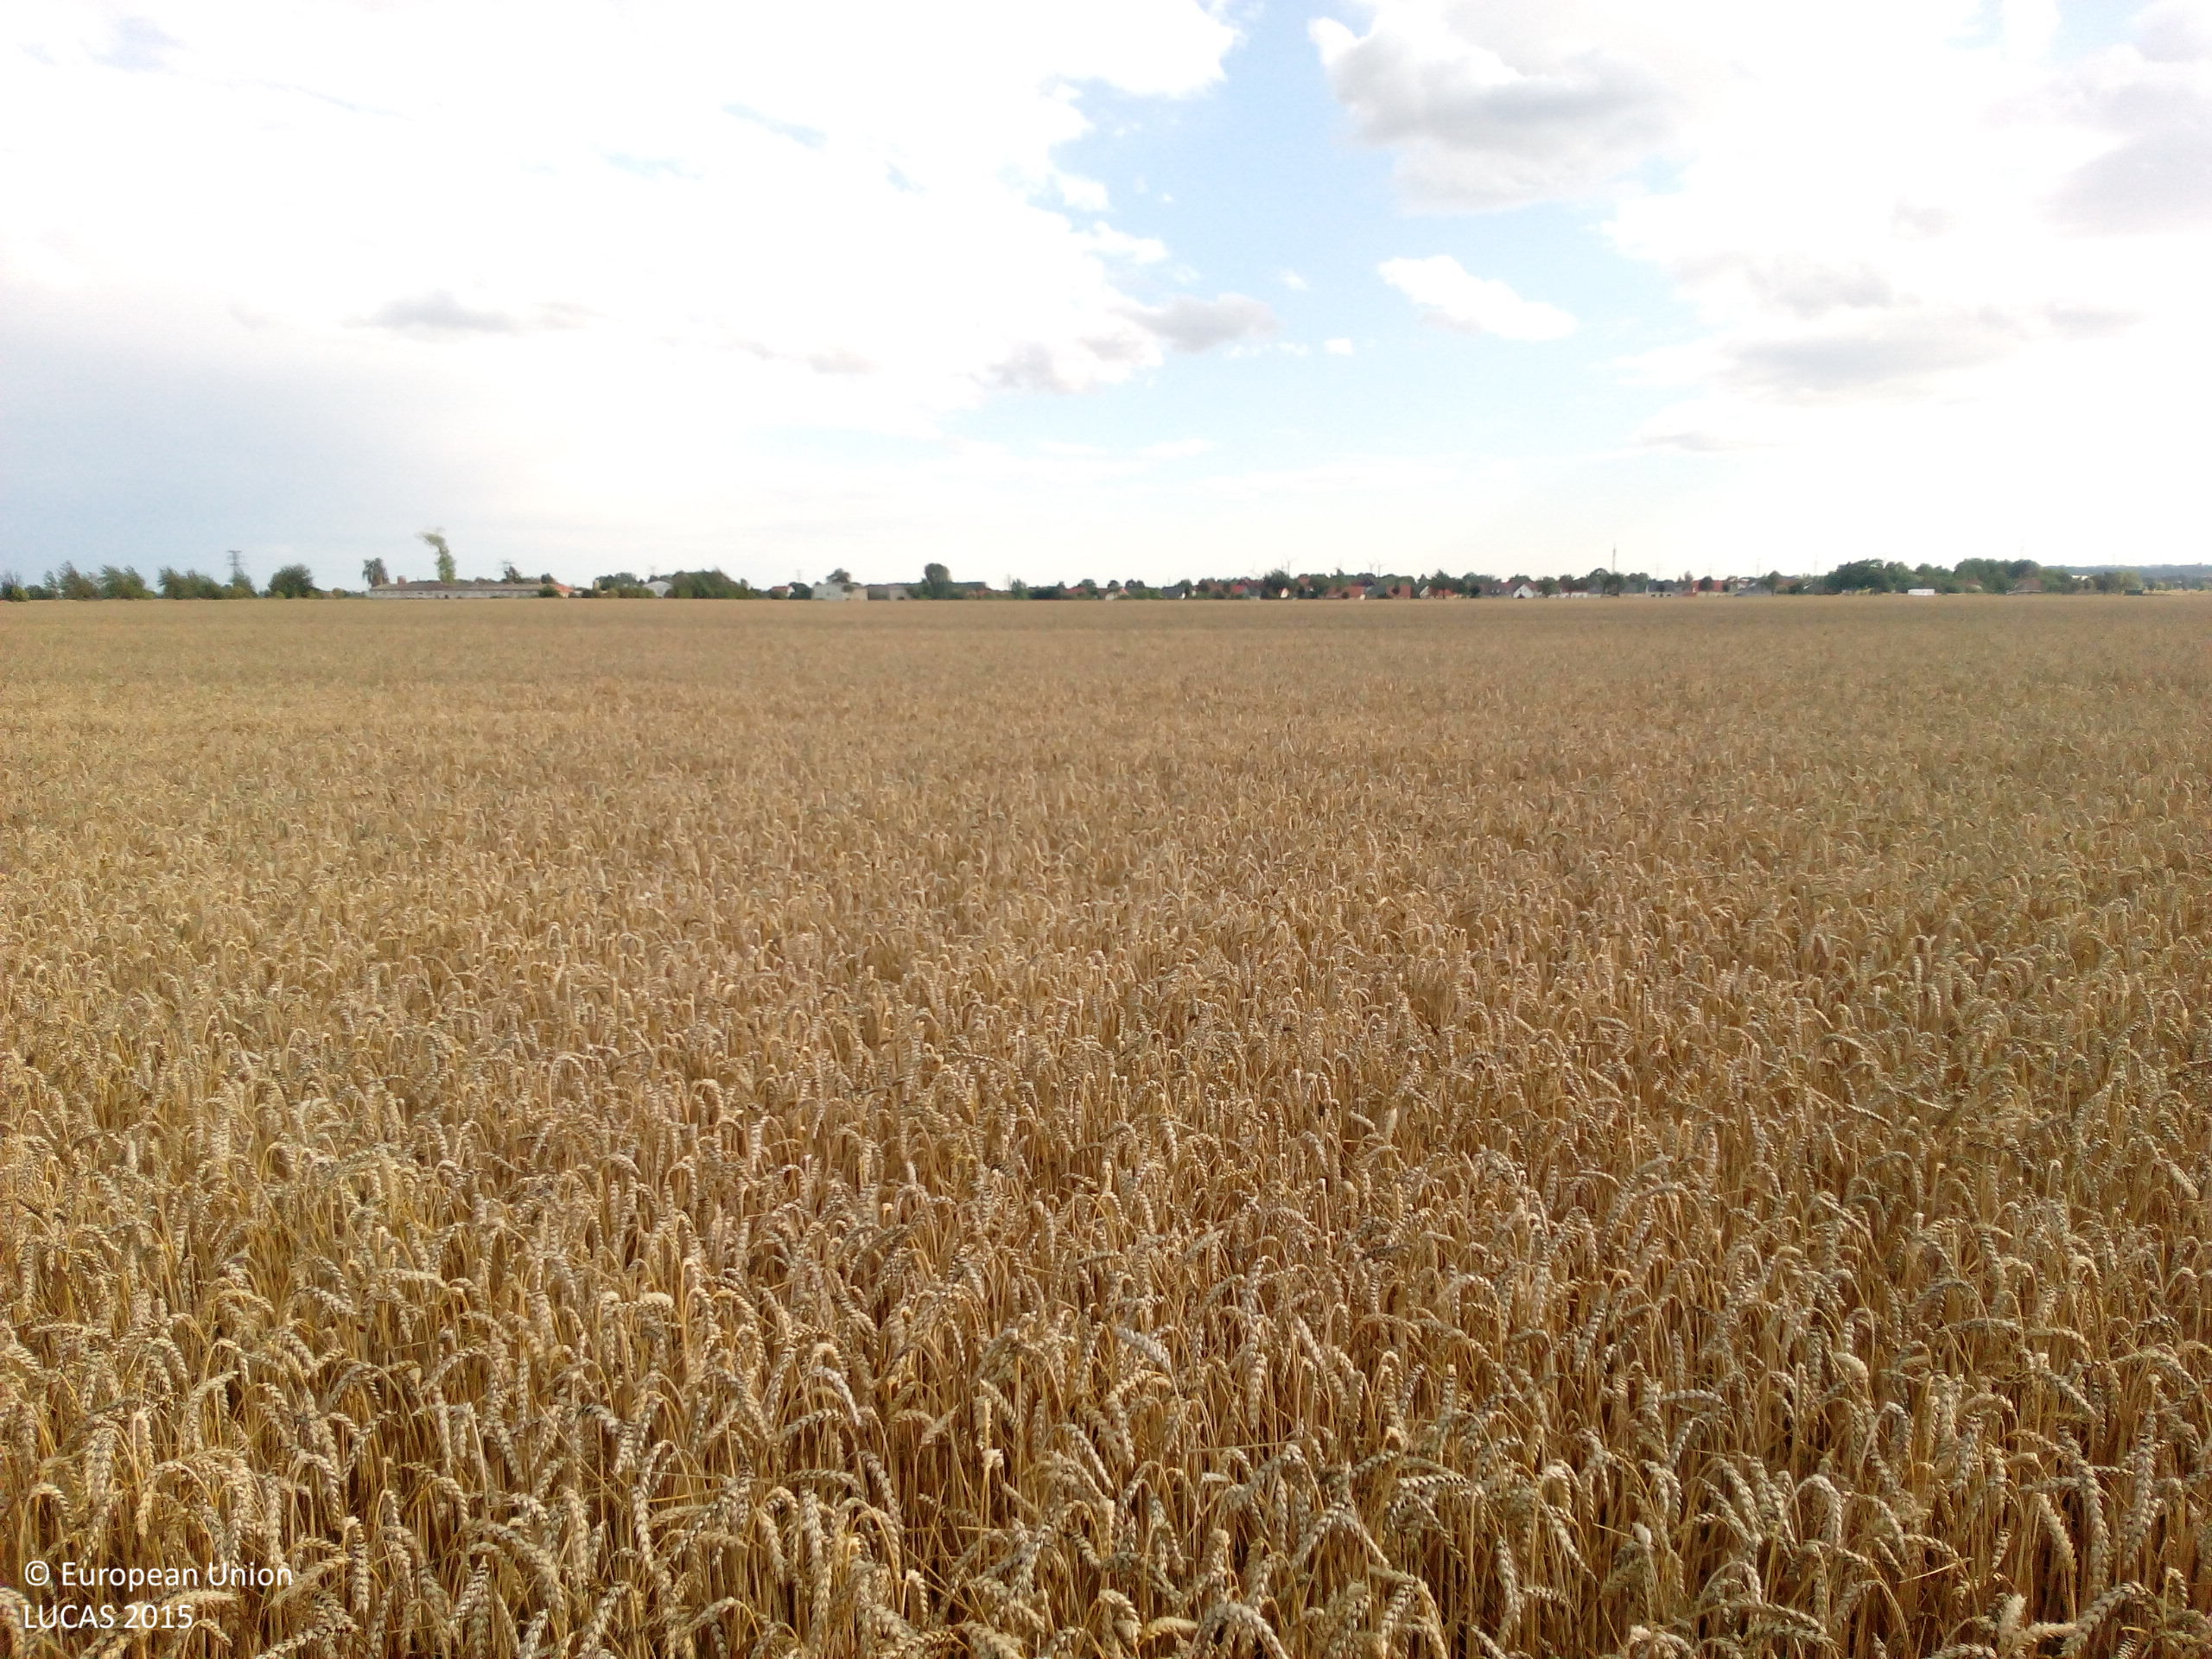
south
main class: Cropland
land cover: Common wheat
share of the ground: > 75 %
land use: Agriculture (excluding fallow land and kitchen gardens)
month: July
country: DE
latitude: 52.2233
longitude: 11.5659
